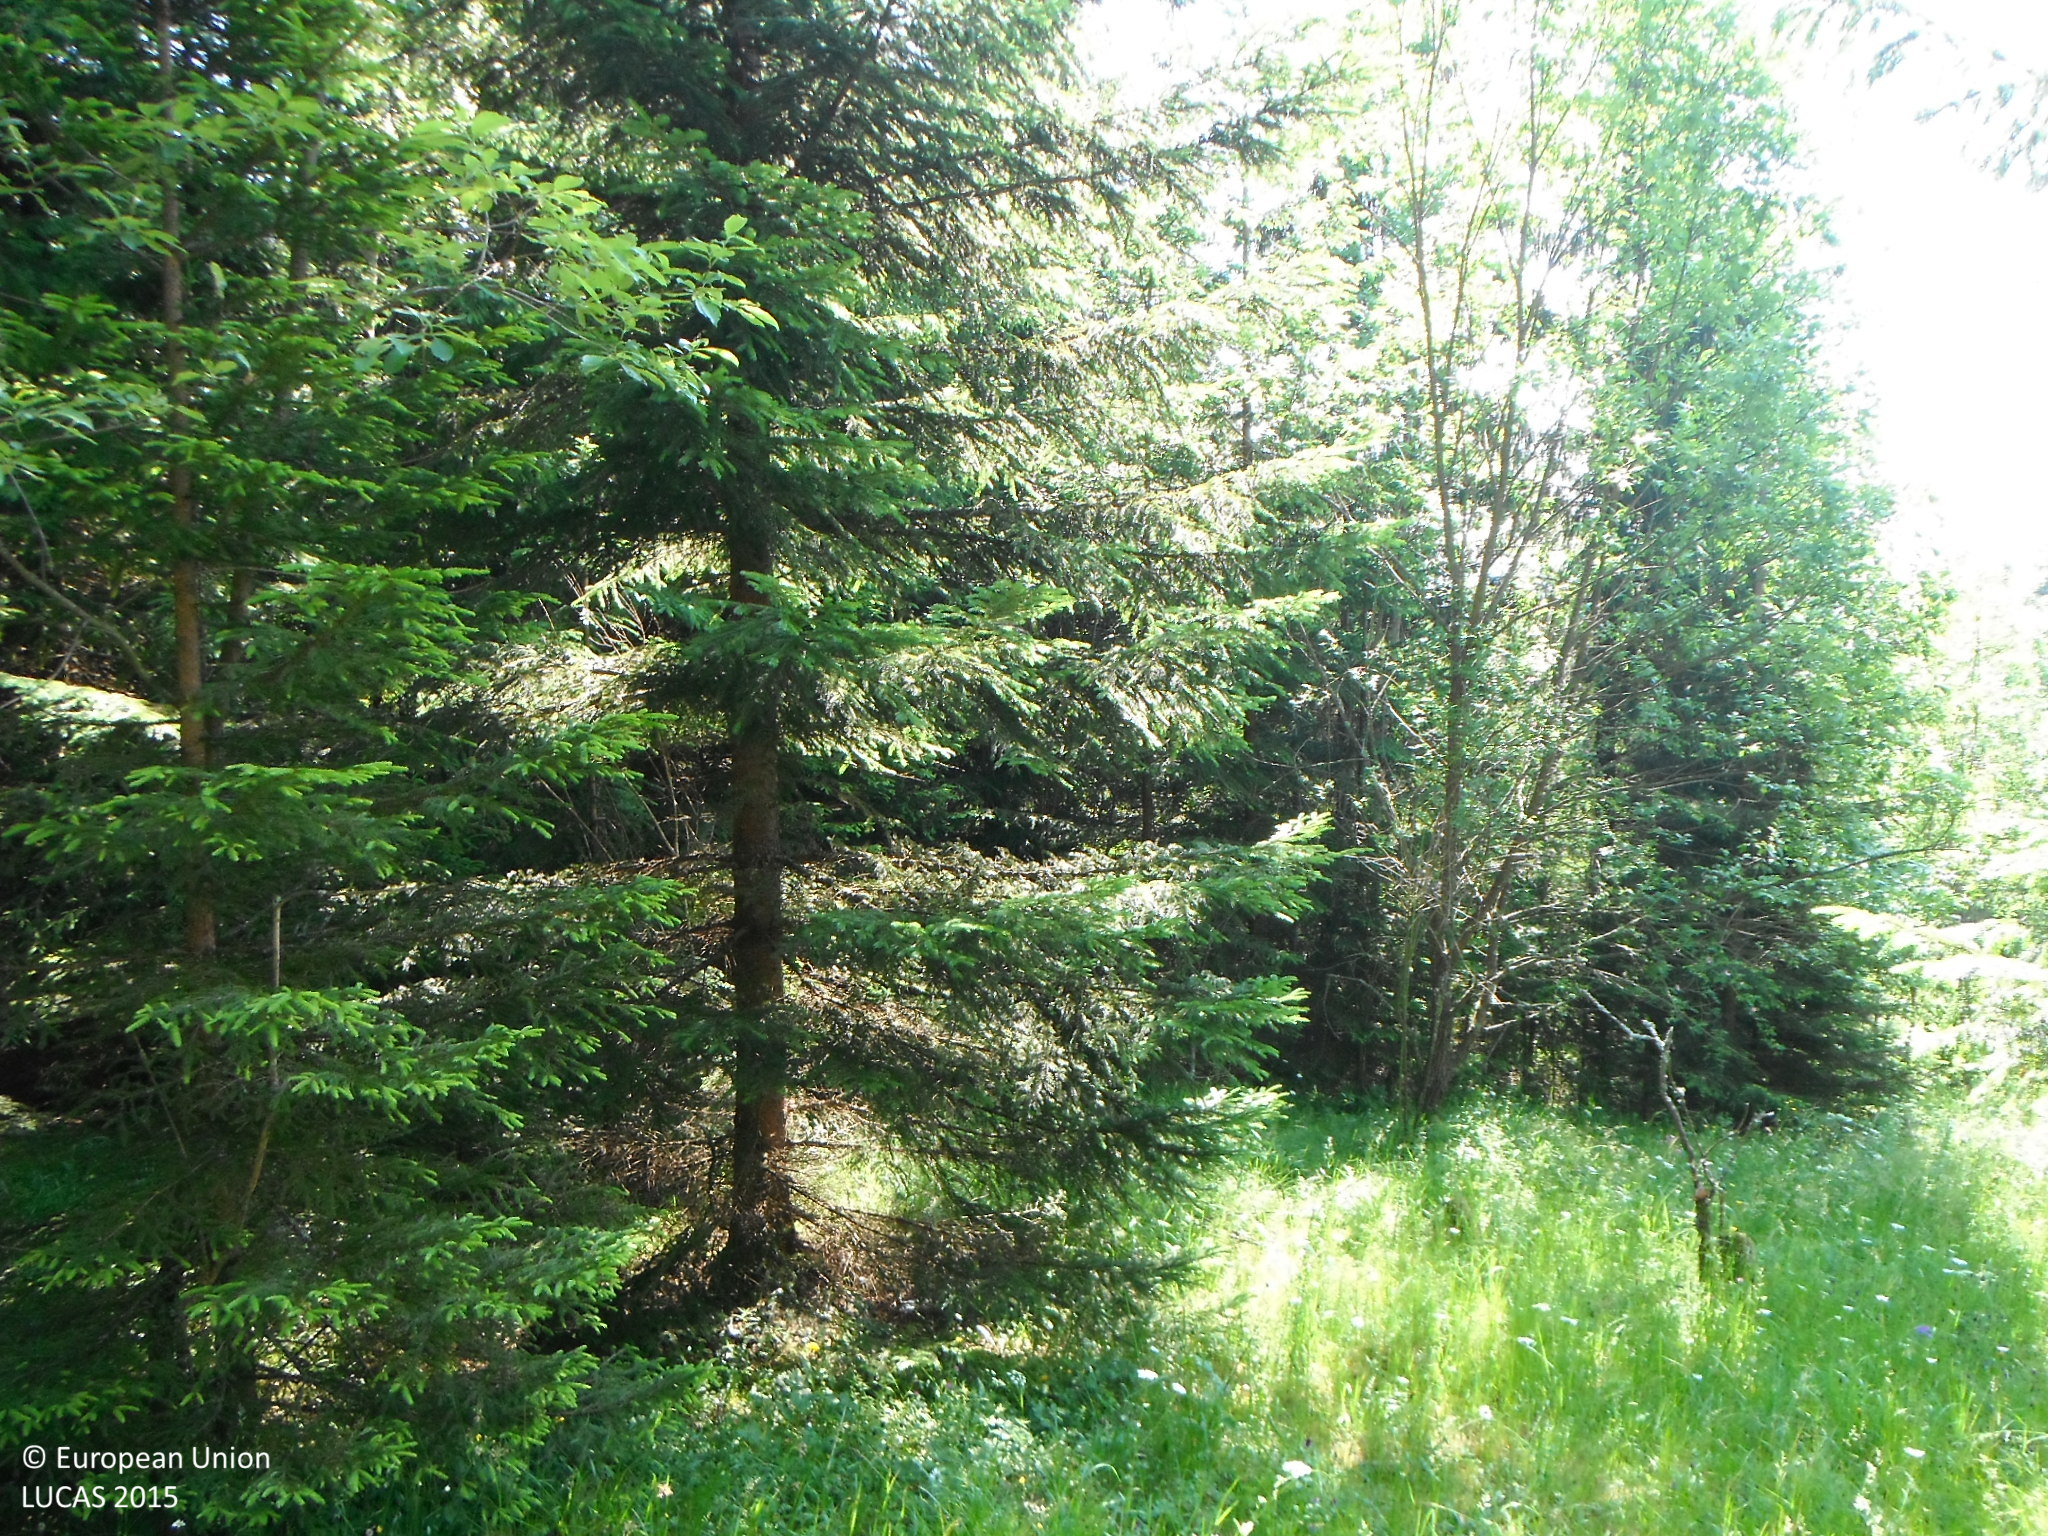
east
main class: Woodland
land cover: Spruce dominated coniferous woodland
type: alpine coniferous forest
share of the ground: > 75 %
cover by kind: coniferous forest trees 75 %, herbaceous plants 20 %, broadleaved forest trees 5 %
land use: Forestry
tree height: > 5 m
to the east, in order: Spruce dominated coniferous woodland; Spruce dominated mixed woodland; Ditches and canals; Tracks; Spruce dominated coniferous woodland; Spontaneously vegetated surfaces; Spruce dominated coniferous woodland
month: July
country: SK
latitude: 49.3960
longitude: 19.4090
